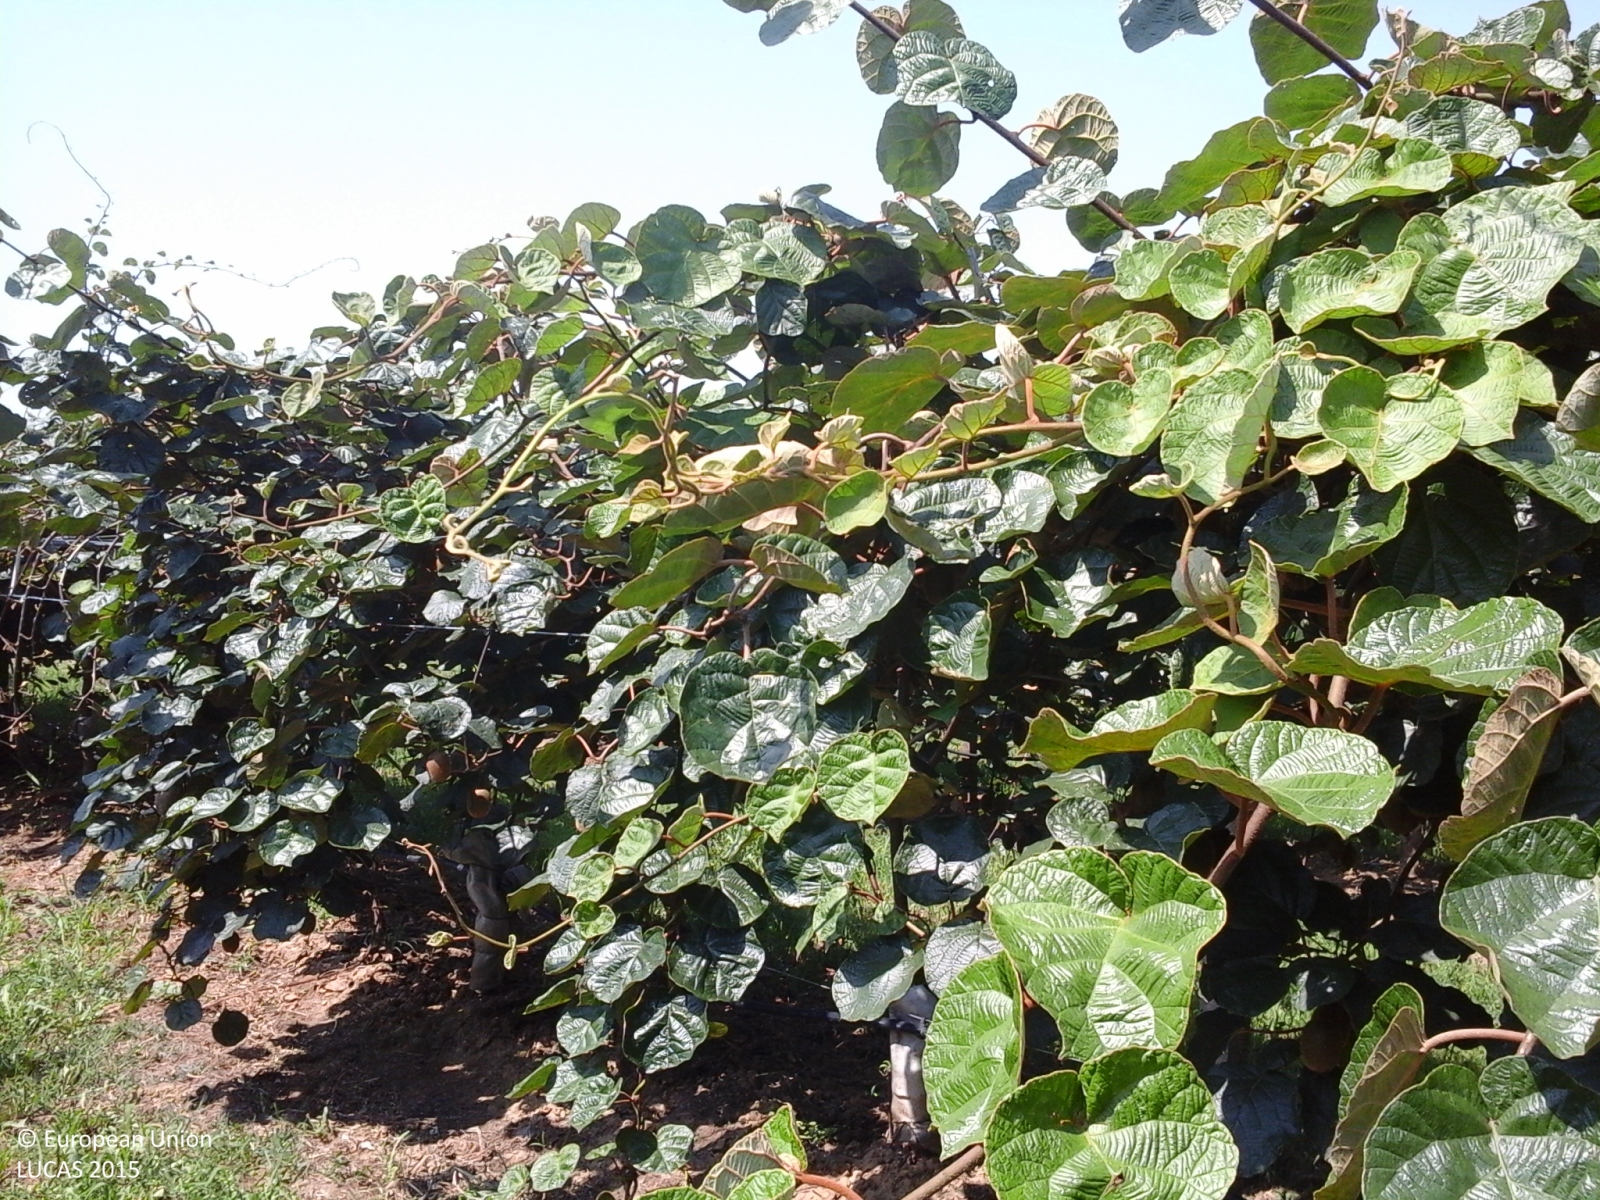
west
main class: Cropland
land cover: Other fruit trees and berries
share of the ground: > 75 %
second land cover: Spontaneously vegetated surfaces
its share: > 75 %
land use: Agriculture (excluding fallow land and kitchen gardens)
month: July
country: IT
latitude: 44.3729
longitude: 11.6905
